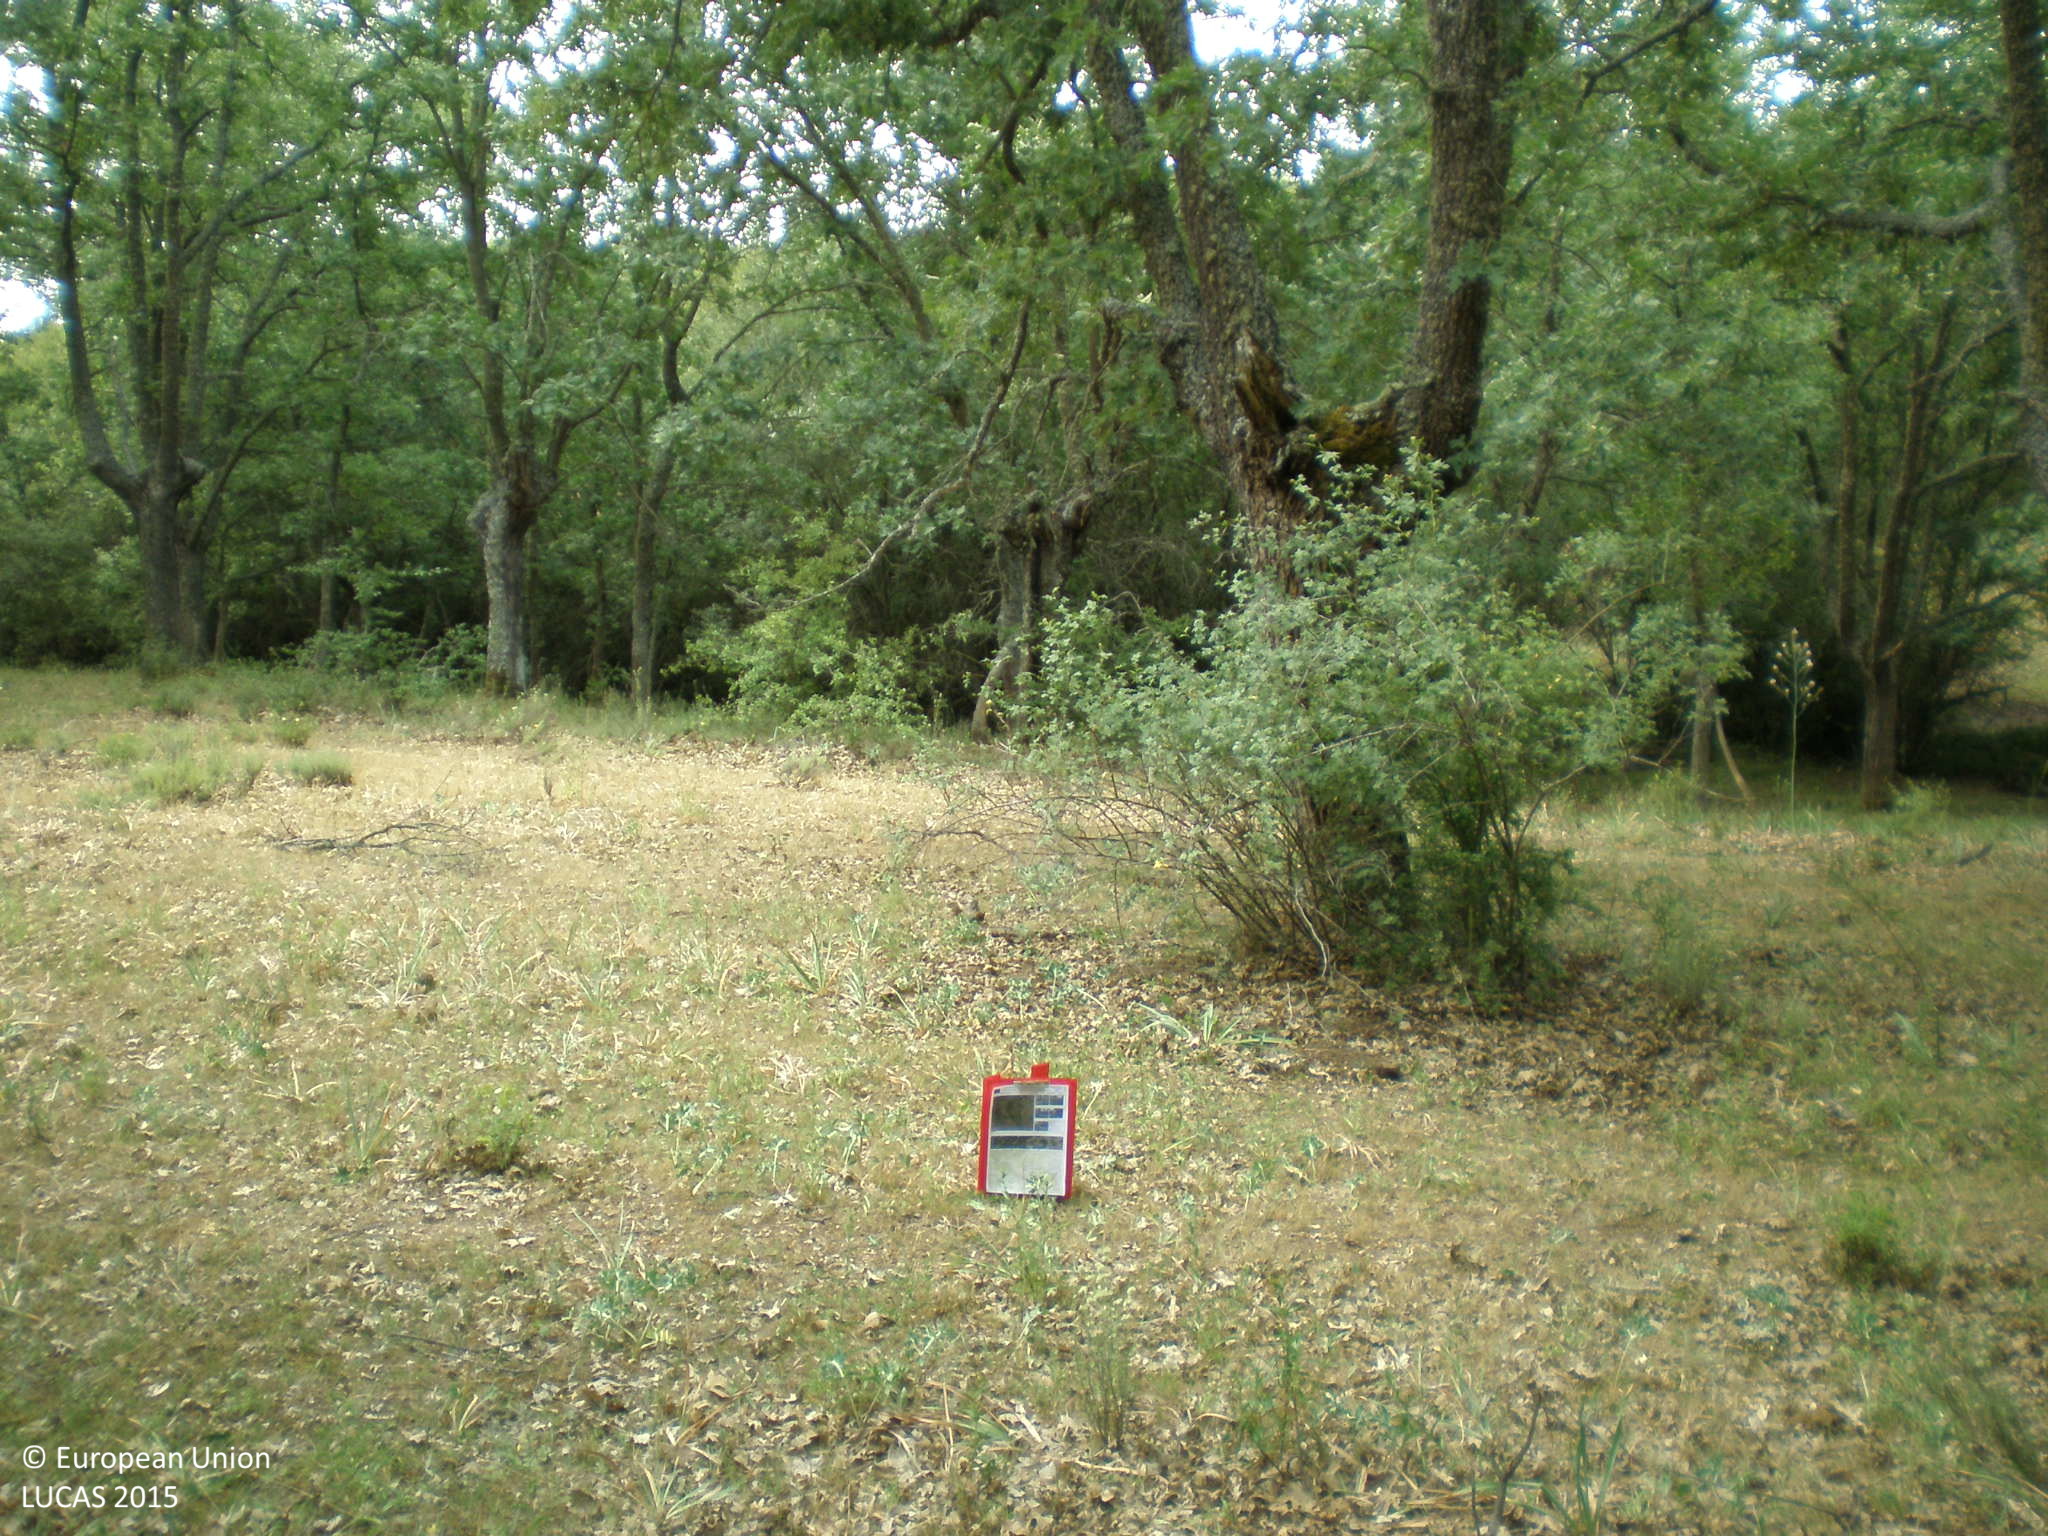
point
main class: Woodland
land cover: Broadleaved woodland
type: thermophilous deciduous forest
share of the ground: > 75 %
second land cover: Grassland without tree/shrub cover
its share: 10 - 25 %
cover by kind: broadleaved forest trees 80 %, herbaceous plants 20 %
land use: Forestry
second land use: Agriculture (excluding fallow land and kitchen gardens)
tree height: > 5 m
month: June
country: ES
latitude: 41.2183
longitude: -5.8169
